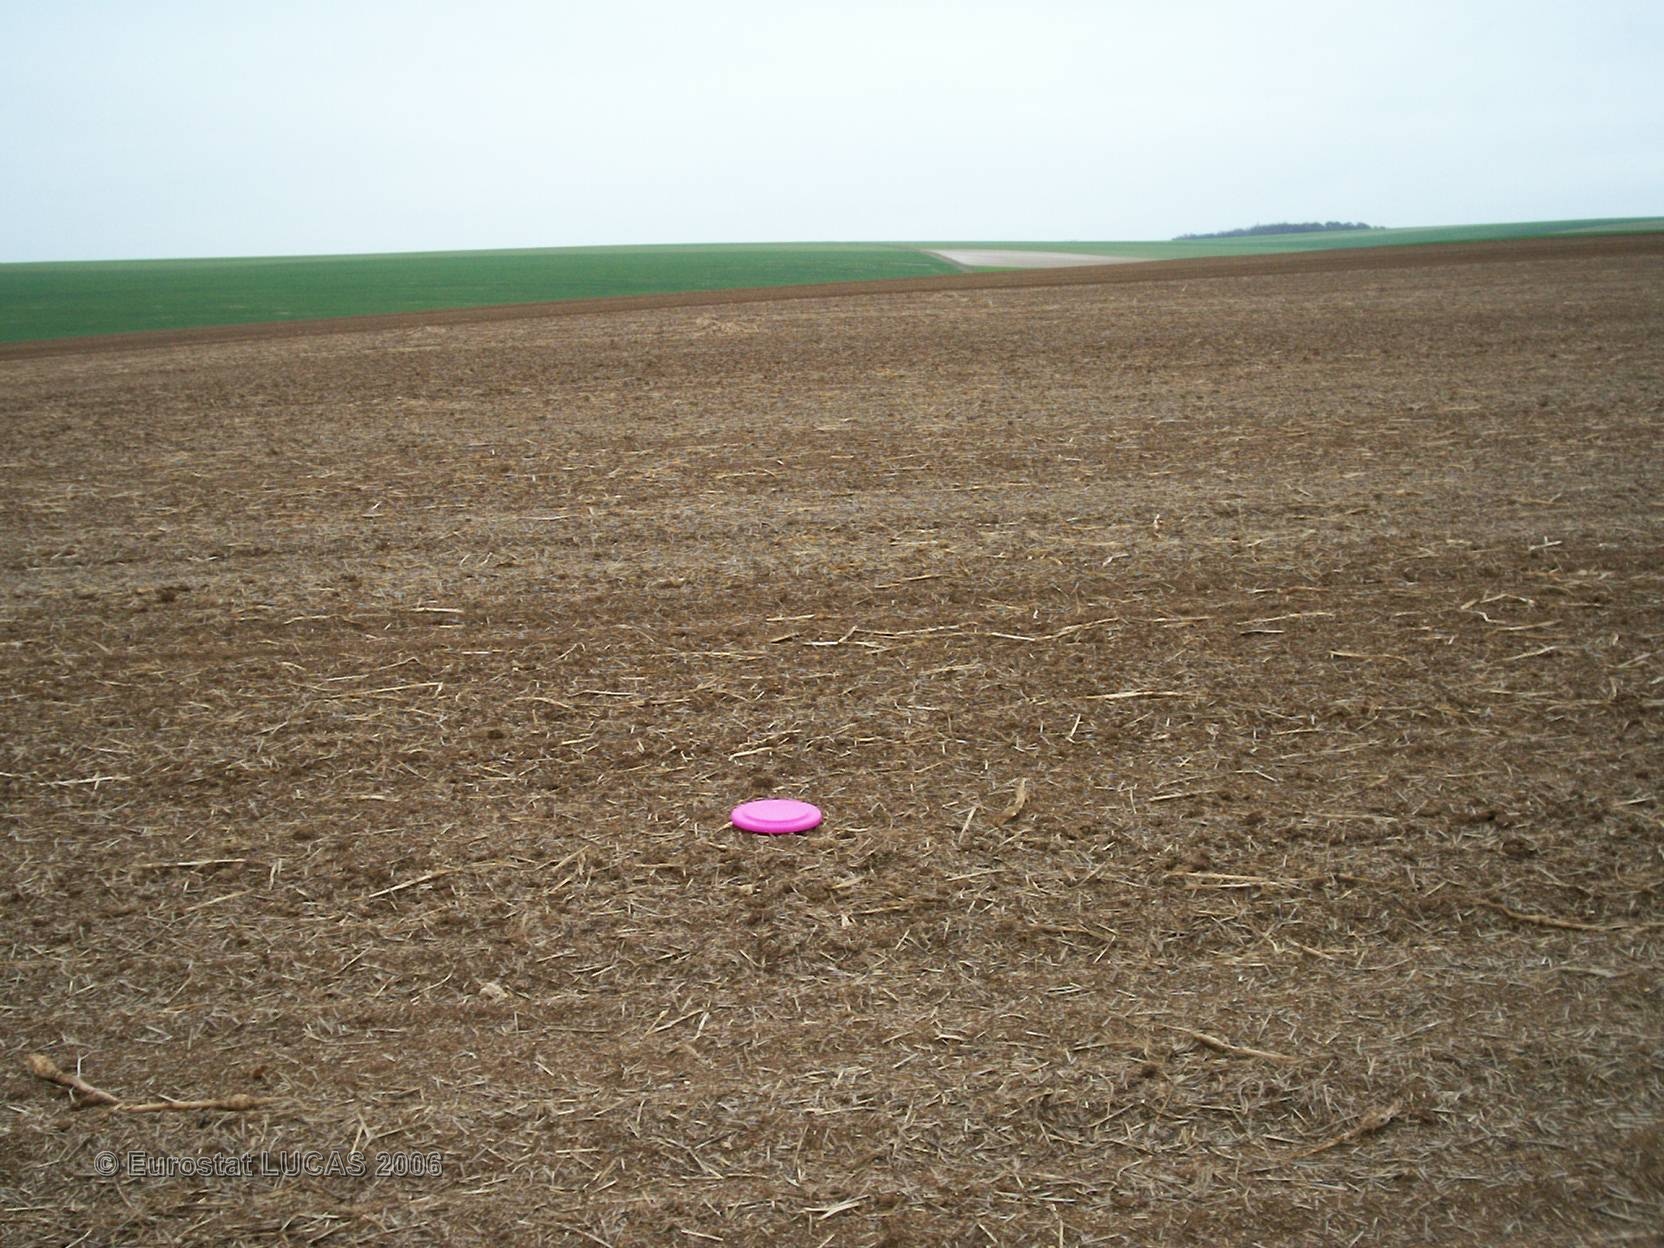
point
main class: Cropland
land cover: Sugar beet
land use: Agriculture (excluding fallow land and kitchen gardens)
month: April
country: FR
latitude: 49.2729
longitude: 4.4298
